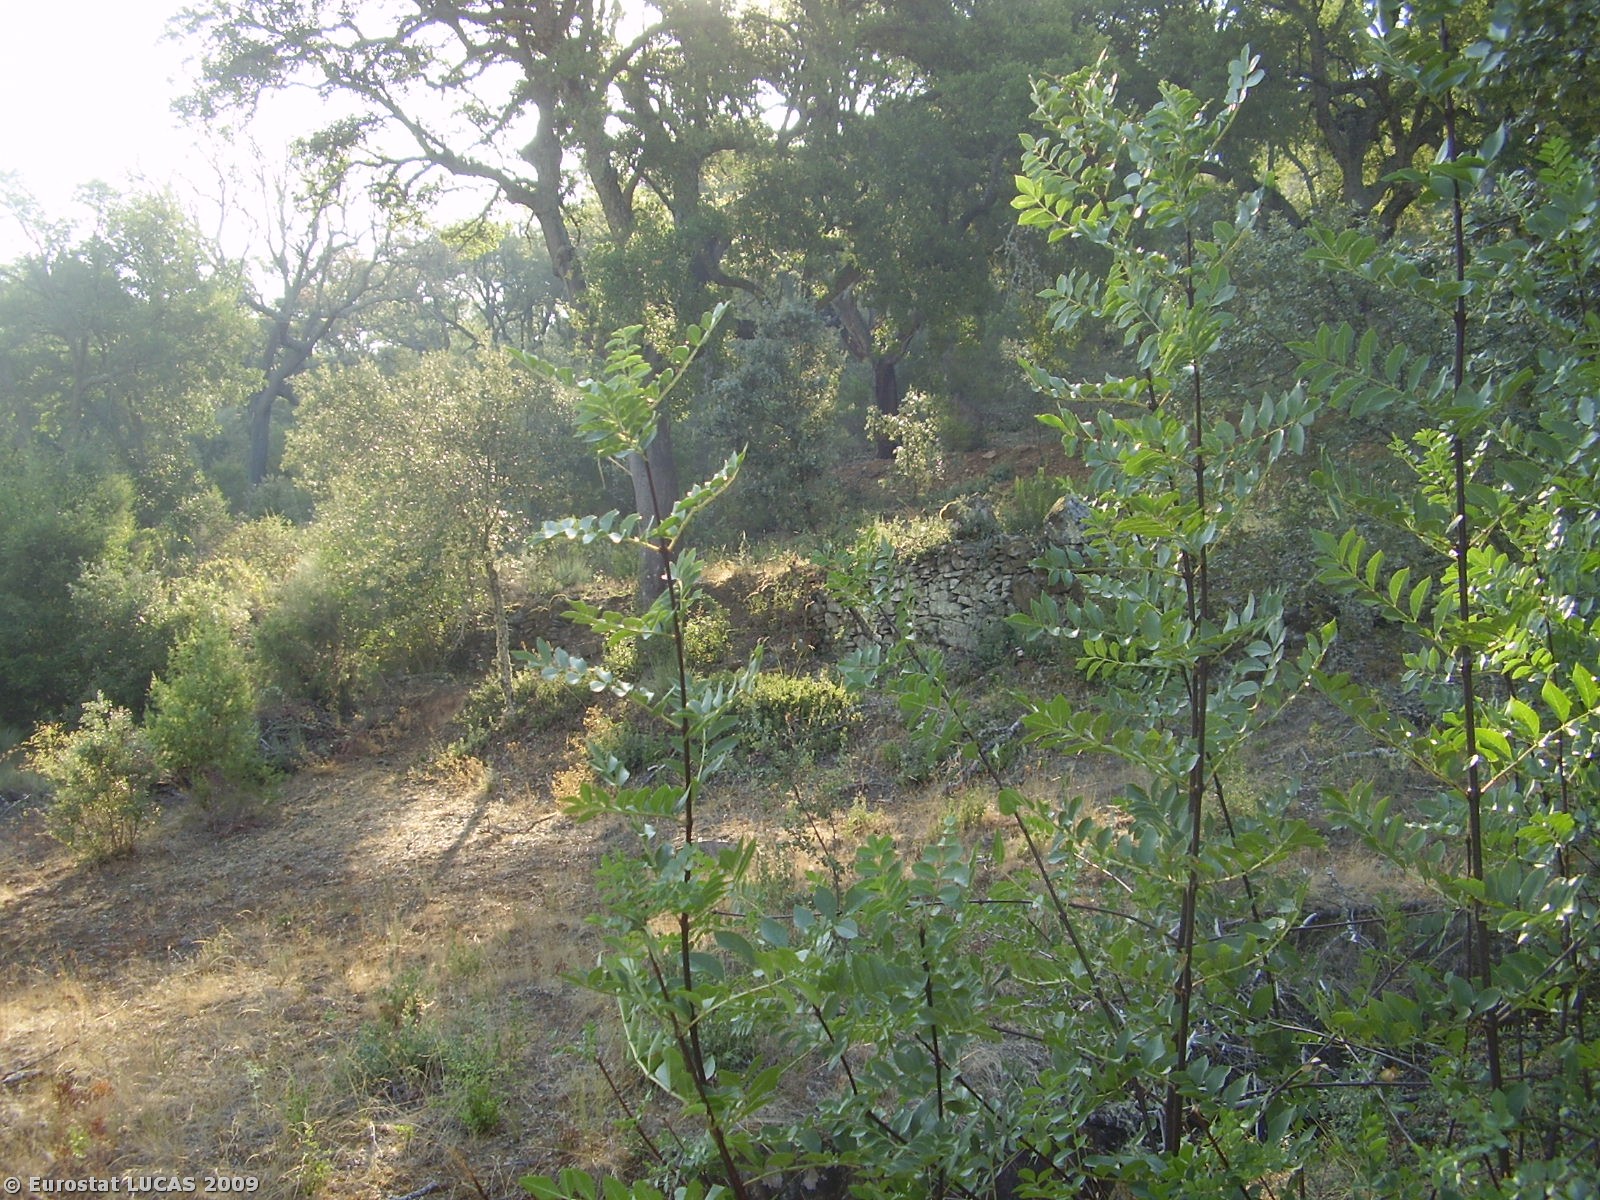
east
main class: Woodland
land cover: Broadleaved woodland
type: broadleaved evergreen forest
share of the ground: 10 - 25 %
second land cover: Spontaneously vegetated surfaces
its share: > 75 %
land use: Forestry
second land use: Fallow land
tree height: > 5 m
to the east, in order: Broadleaved woodland; Spontaneously vegetated surfaces; Broadleaved woodland; Electric lines; Rivers and streams; Broadleaved woodland; Dry stone walls; Broadleaved woodland; Tracks; Broadleaved woodland; Tracks; Broadleaved woodland; Dry stone walls; Broadleaved woodland
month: August
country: PT
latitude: 41.3879
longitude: -6.7904
